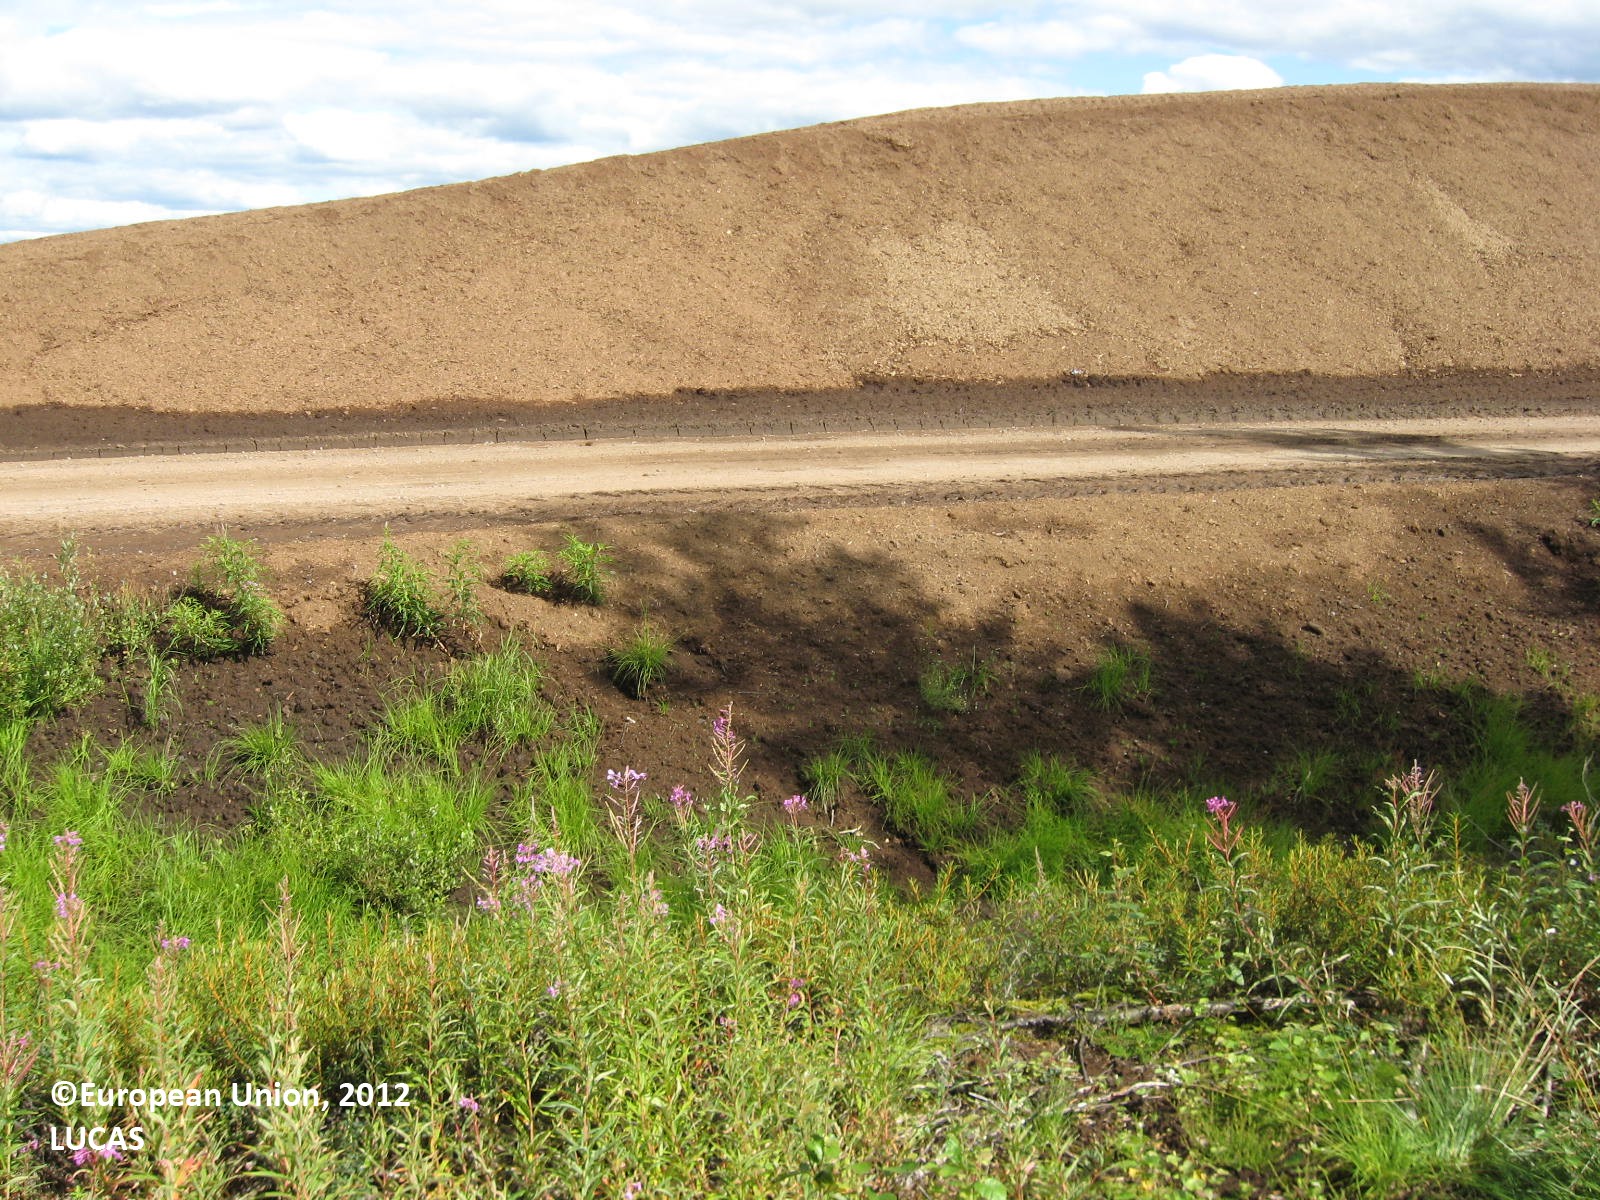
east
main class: Woodland
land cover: Pine dominated coniferous woodland
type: boreal forest
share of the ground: > 75 %
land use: Forestry
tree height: > 5 m
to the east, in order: Pine dominated coniferous woodland; Ditches and canals; Grass margins; Paved roads, cycling and walking lanes; Peatbogs
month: July
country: FI
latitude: 61.9903
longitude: 22.3695
